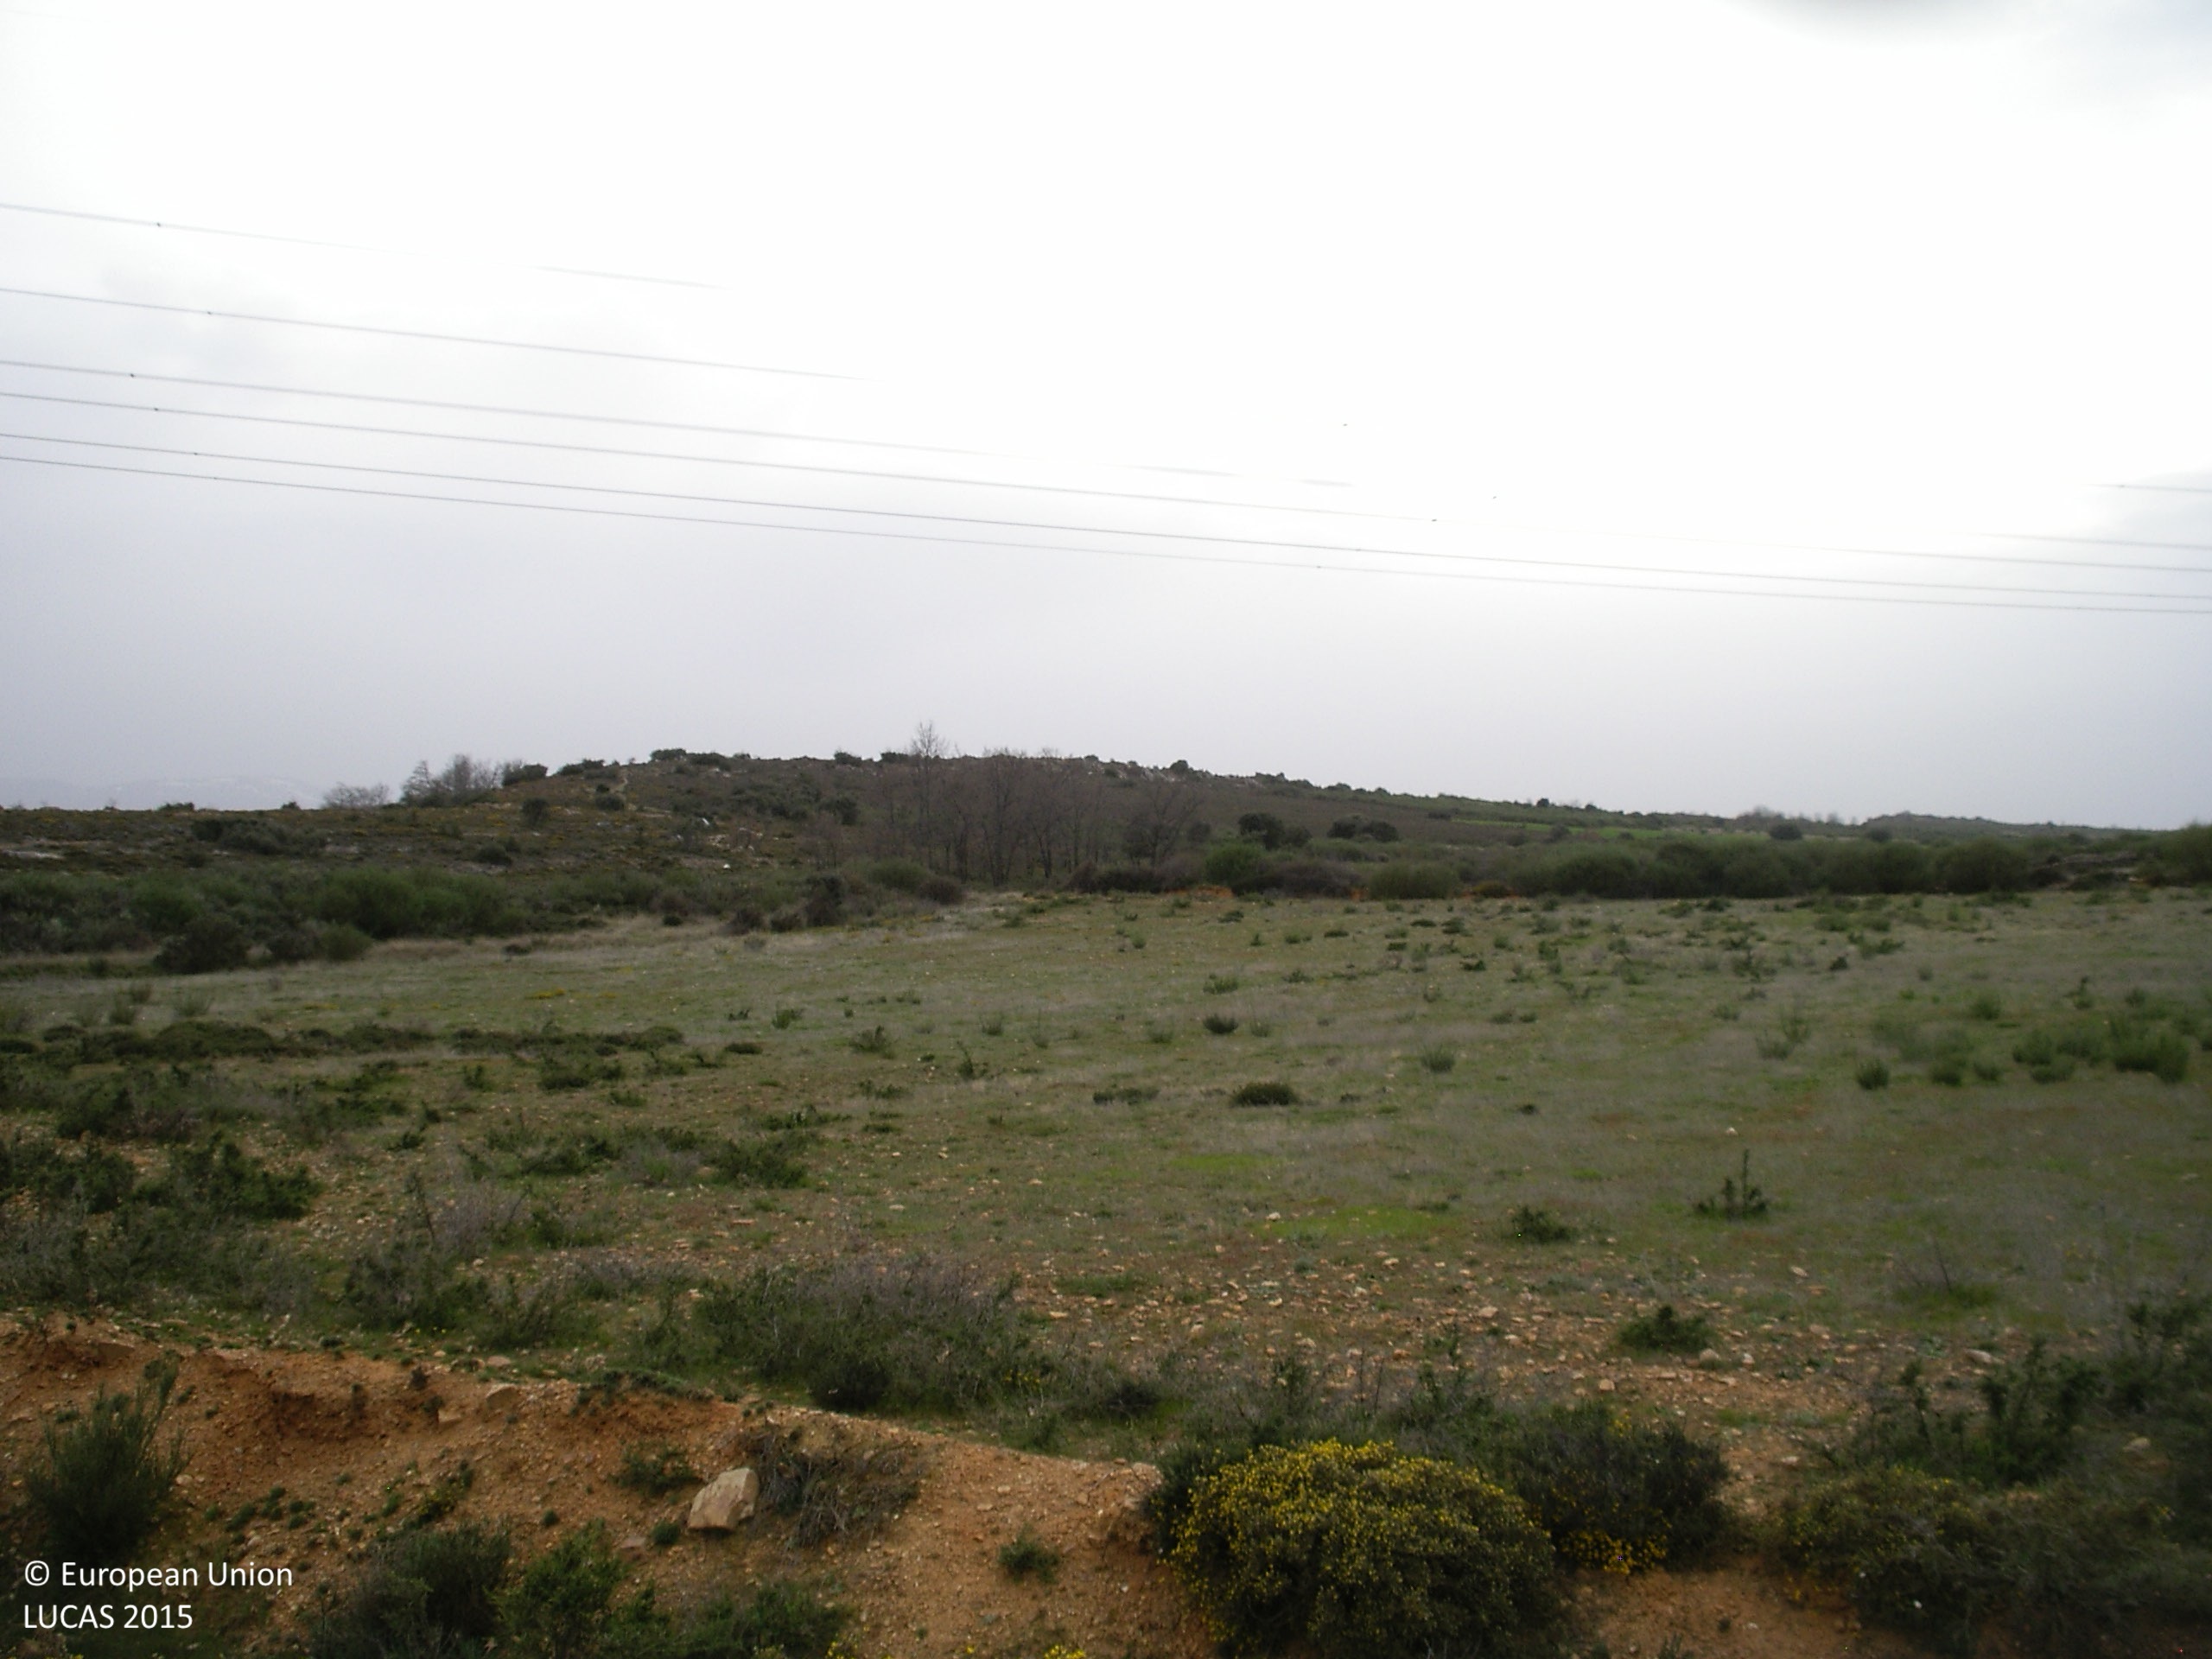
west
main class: Cropland
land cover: Durum wheat
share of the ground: 50 - 75 %
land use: Agriculture (excluding fallow land and kitchen gardens)
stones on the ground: 10 - 25 %
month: April
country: ES
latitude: 42.4905
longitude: -6.1315
